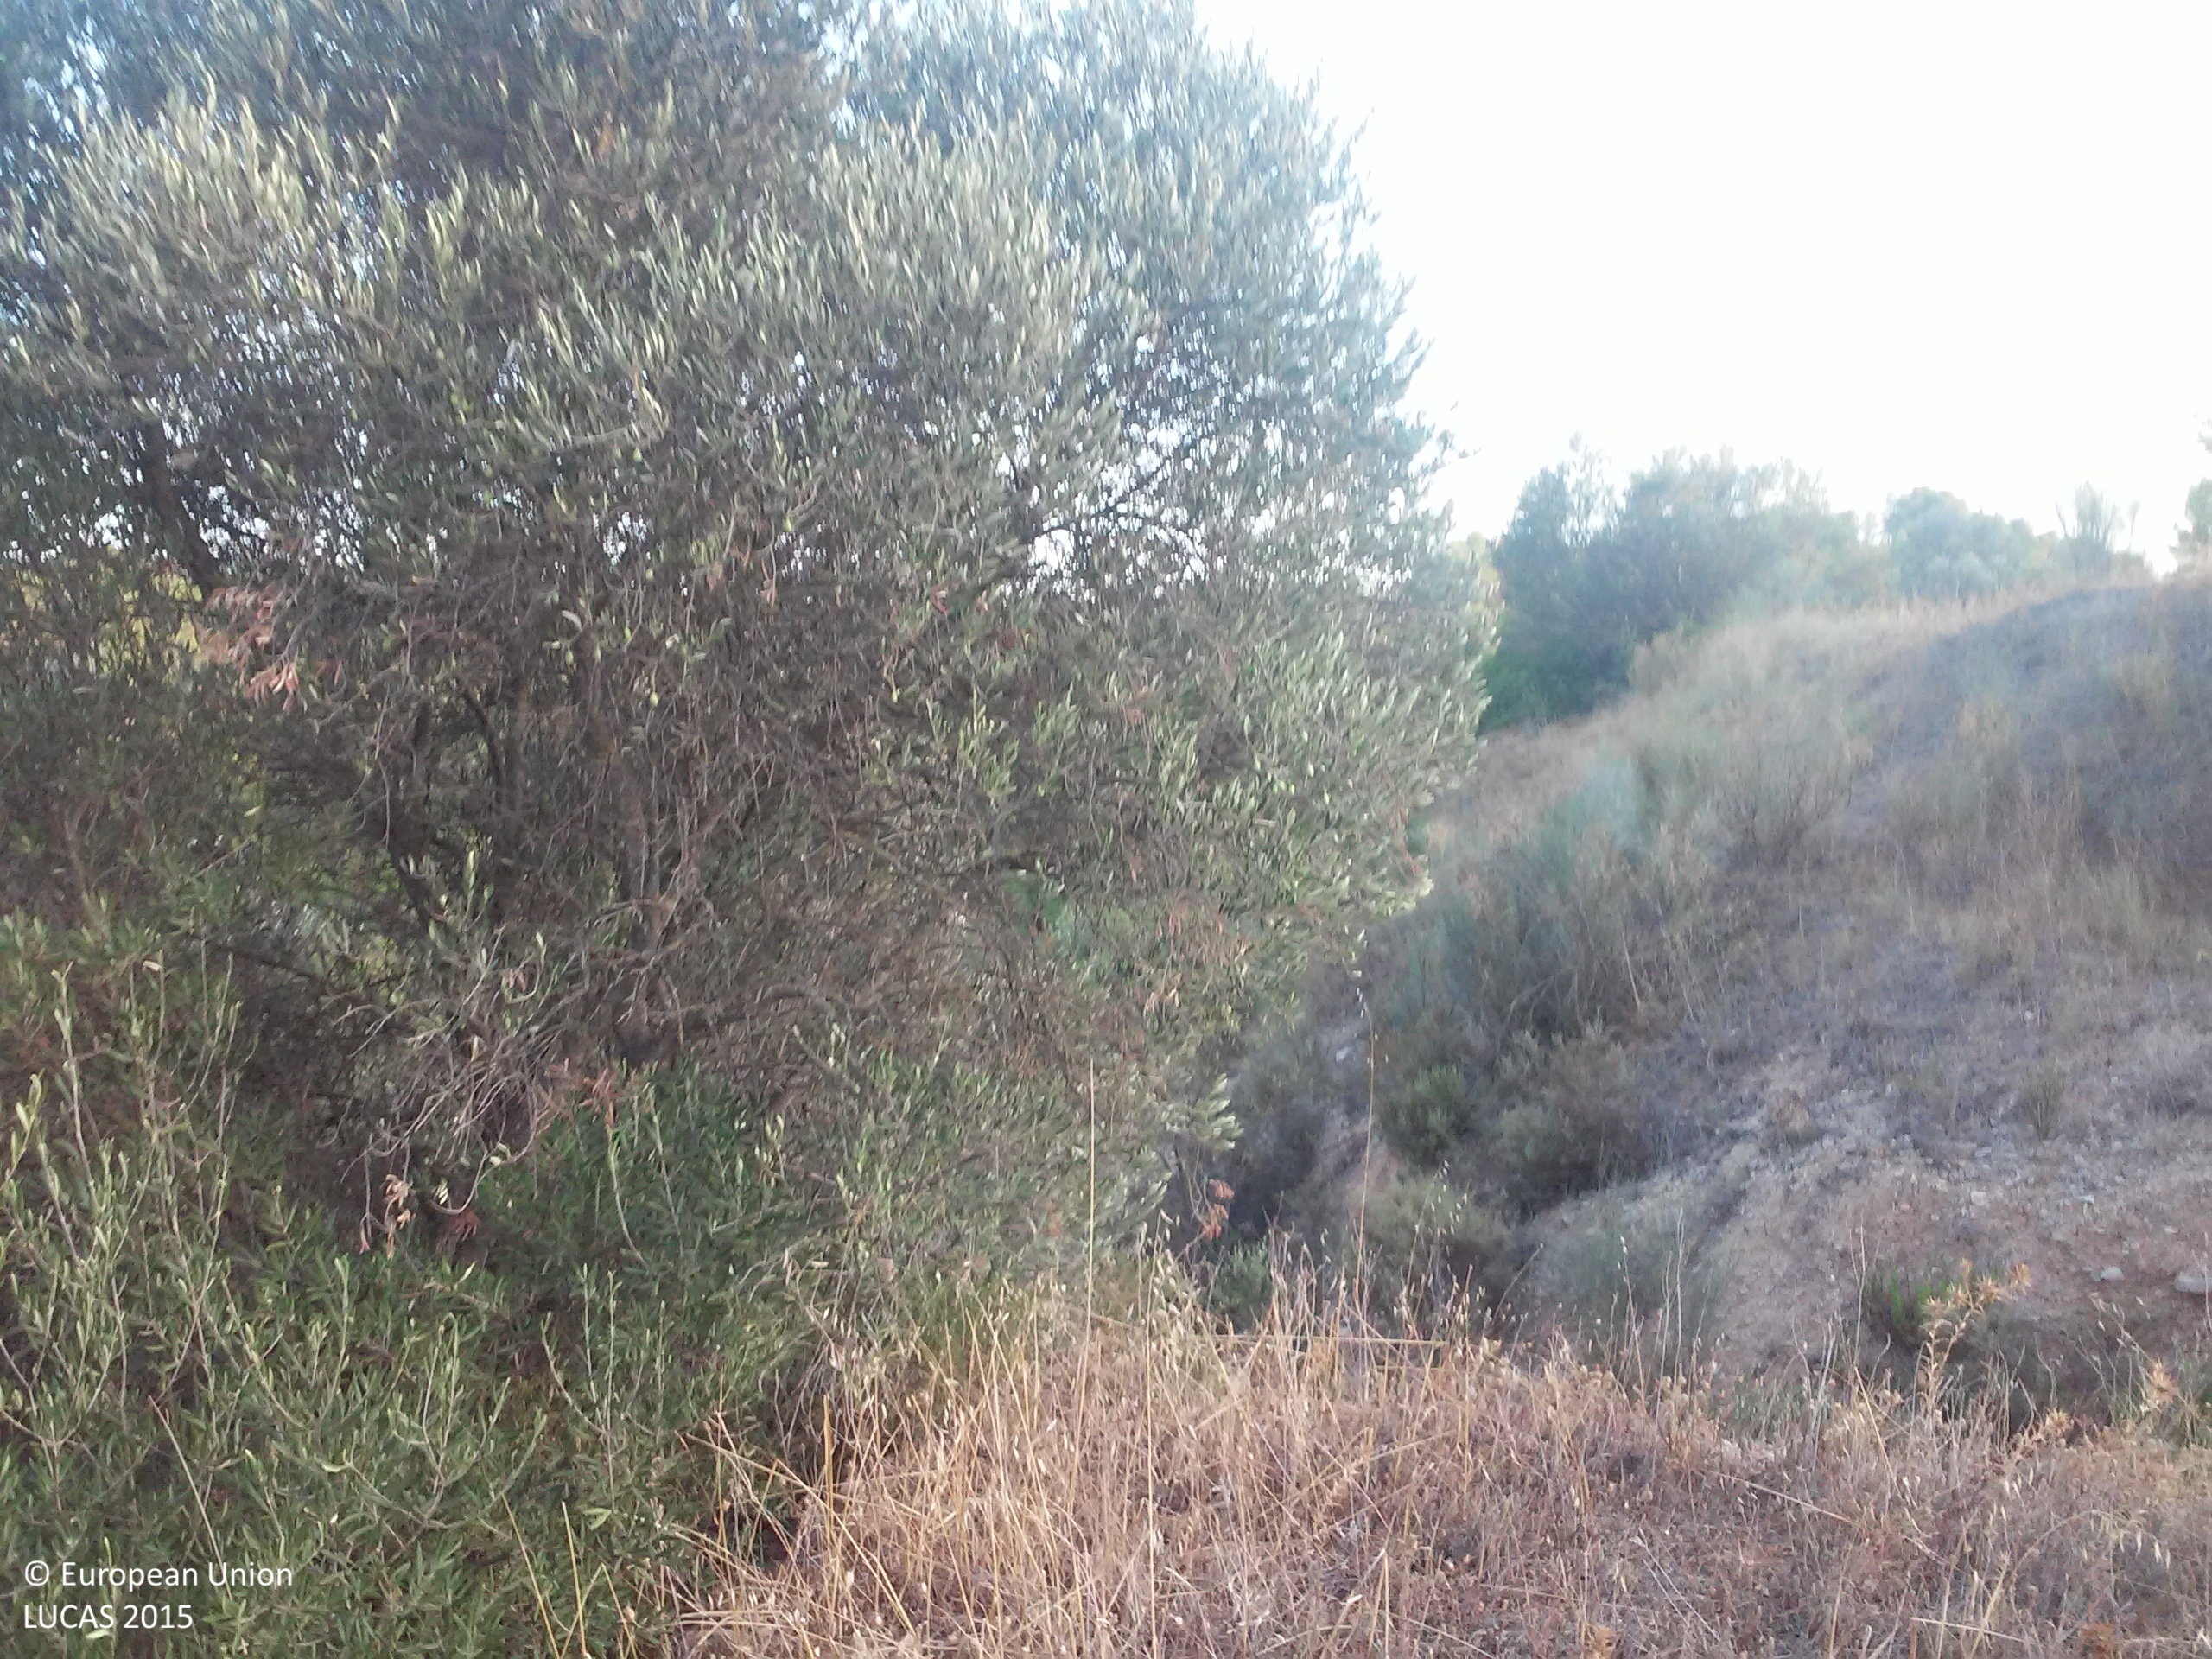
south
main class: Grassland
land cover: Grassland without tree/shrub cover
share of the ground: > 75 %
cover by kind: herbaceous plants 90 %, consolidated bare surface 10 %
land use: Semi-natural and natural areas not in use
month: August
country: ES
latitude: 41.1583
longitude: 0.5647
